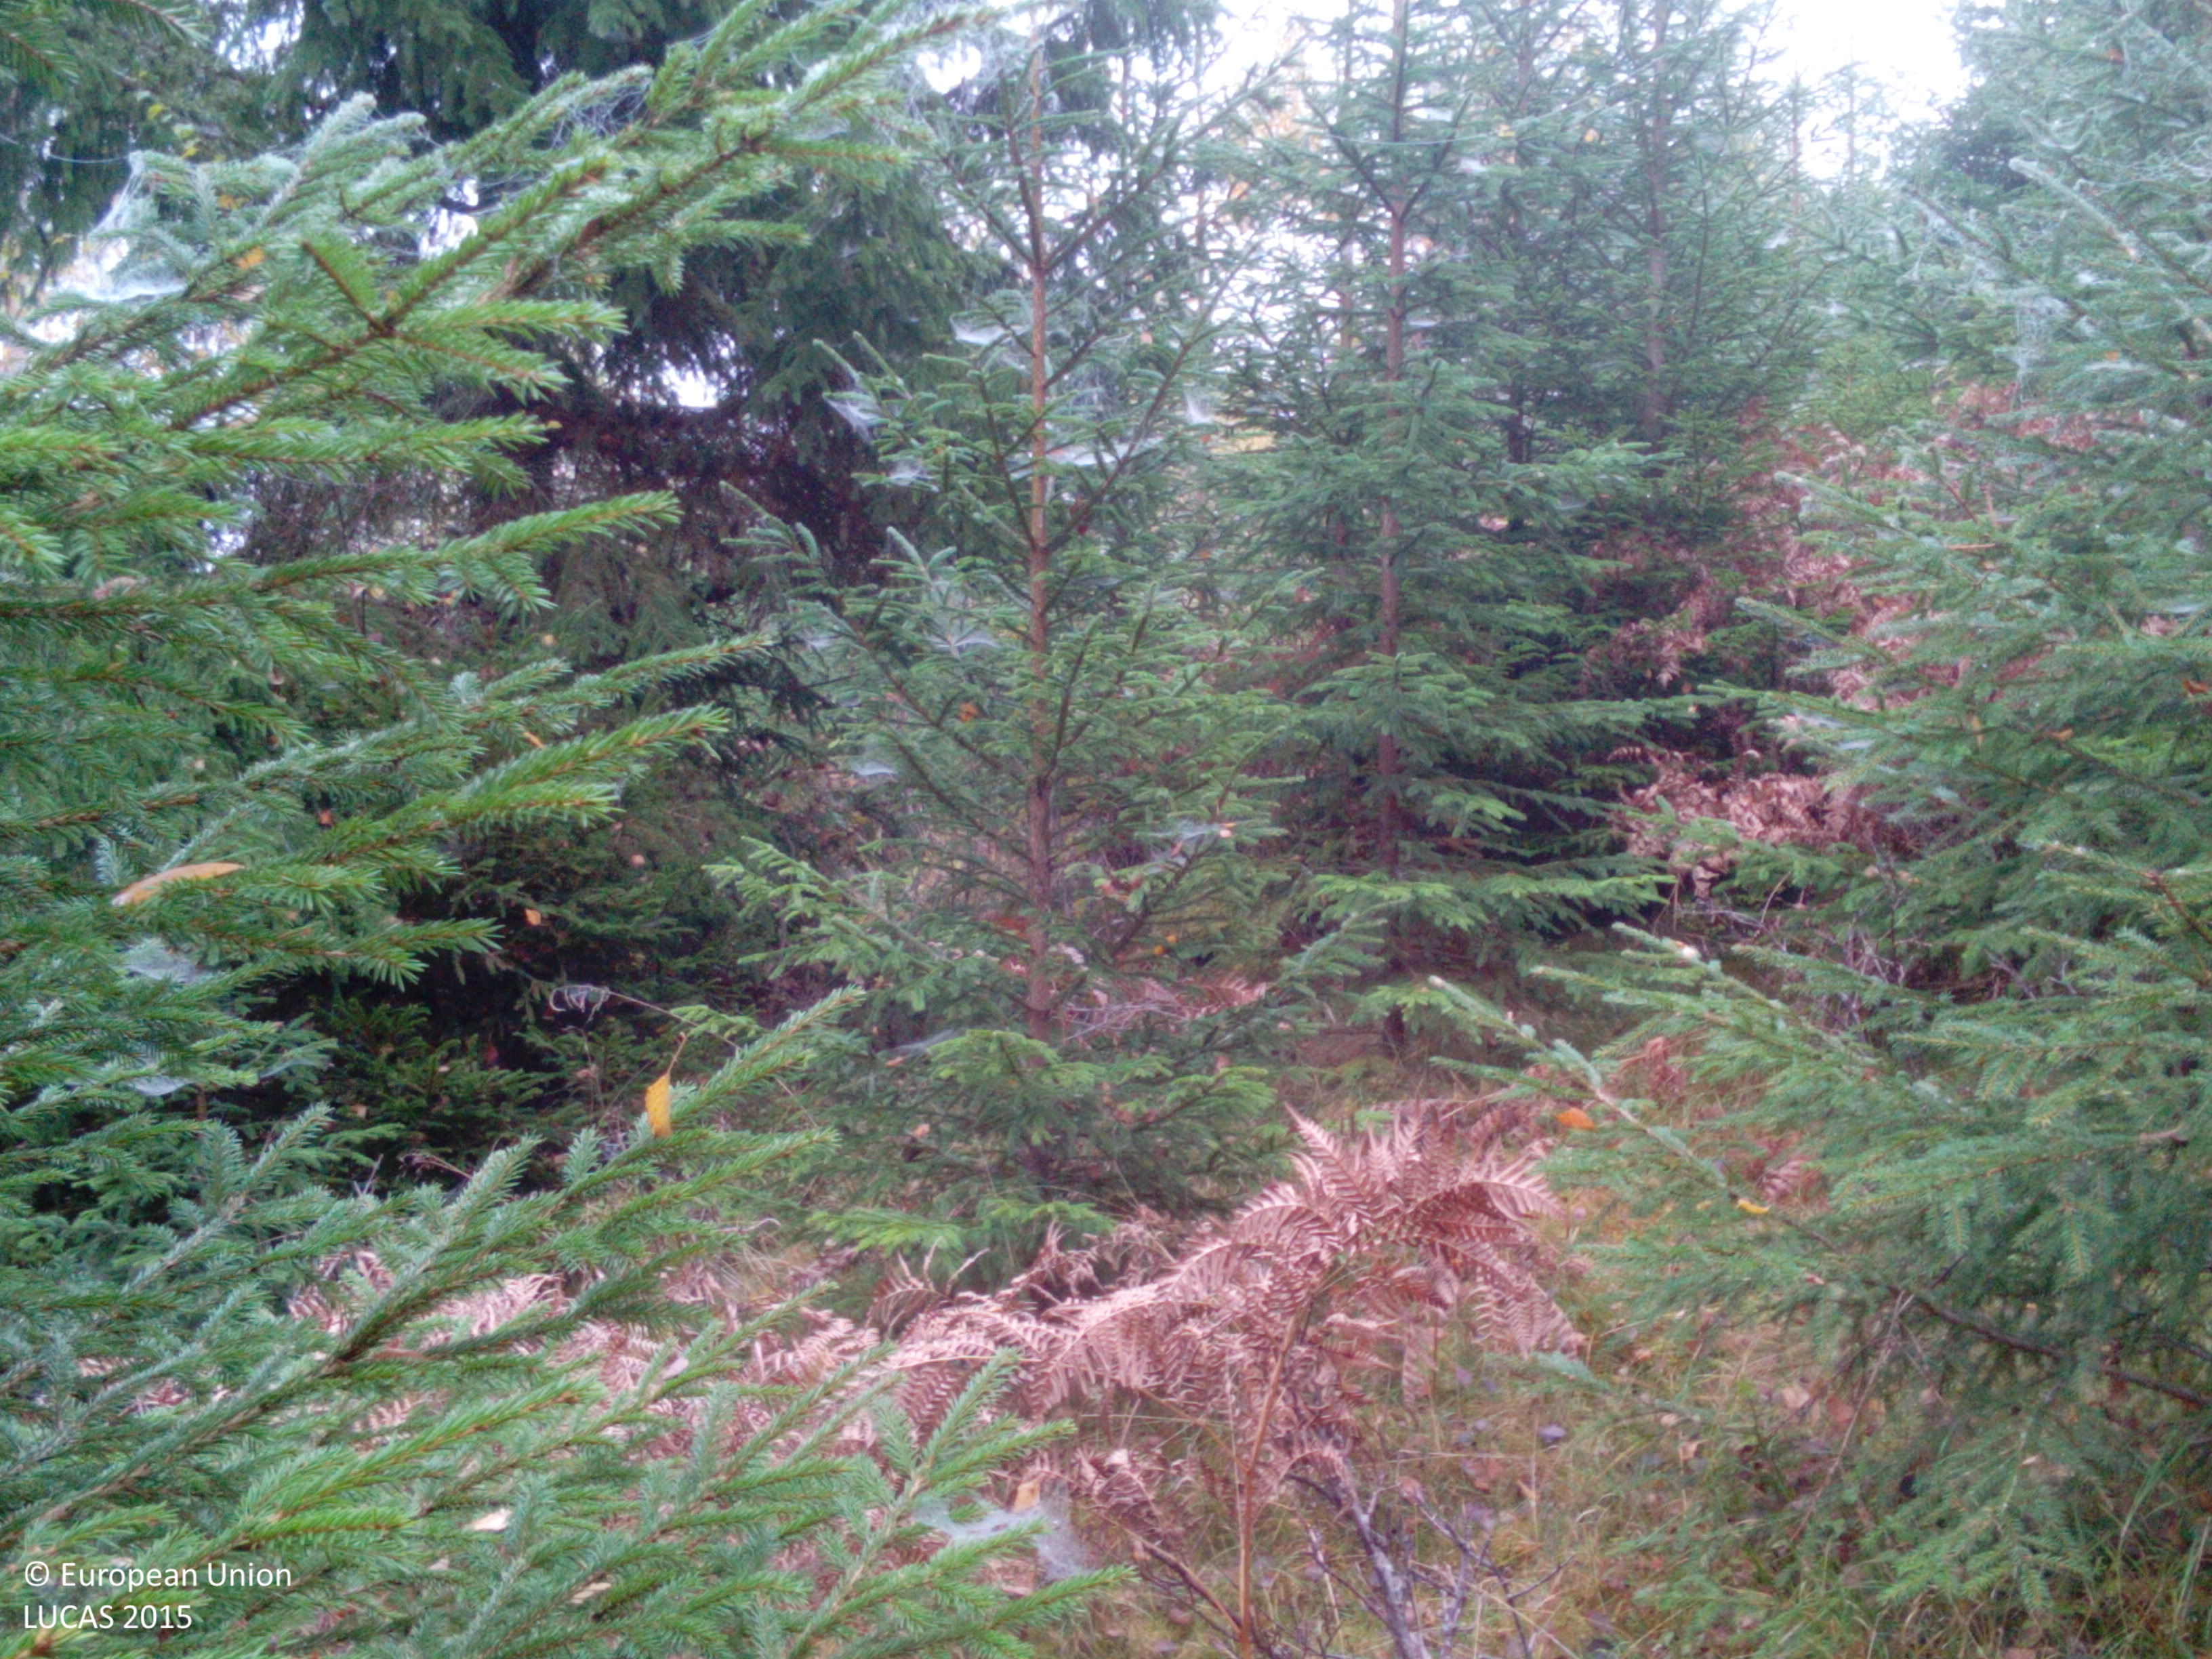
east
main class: Woodland
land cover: Spruce dominated mixed woodland
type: boreal forest
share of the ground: > 75 %
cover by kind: coniferous forest trees 60 %, broadleaved forest trees 25 %, herbaceous plants 15 %
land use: Forestry
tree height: > 5 m
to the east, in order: Spruce dominated mixed woodland; Grassland with sparse tree/shrub cover; Paved roads, cycling and walking lanes; Grassland without tree/shrub cover; Ditches and canals; Grass margins; Paved roads, cycling and walking lanes; Oats
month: October
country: SE
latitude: 58.9692
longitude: 16.4119
